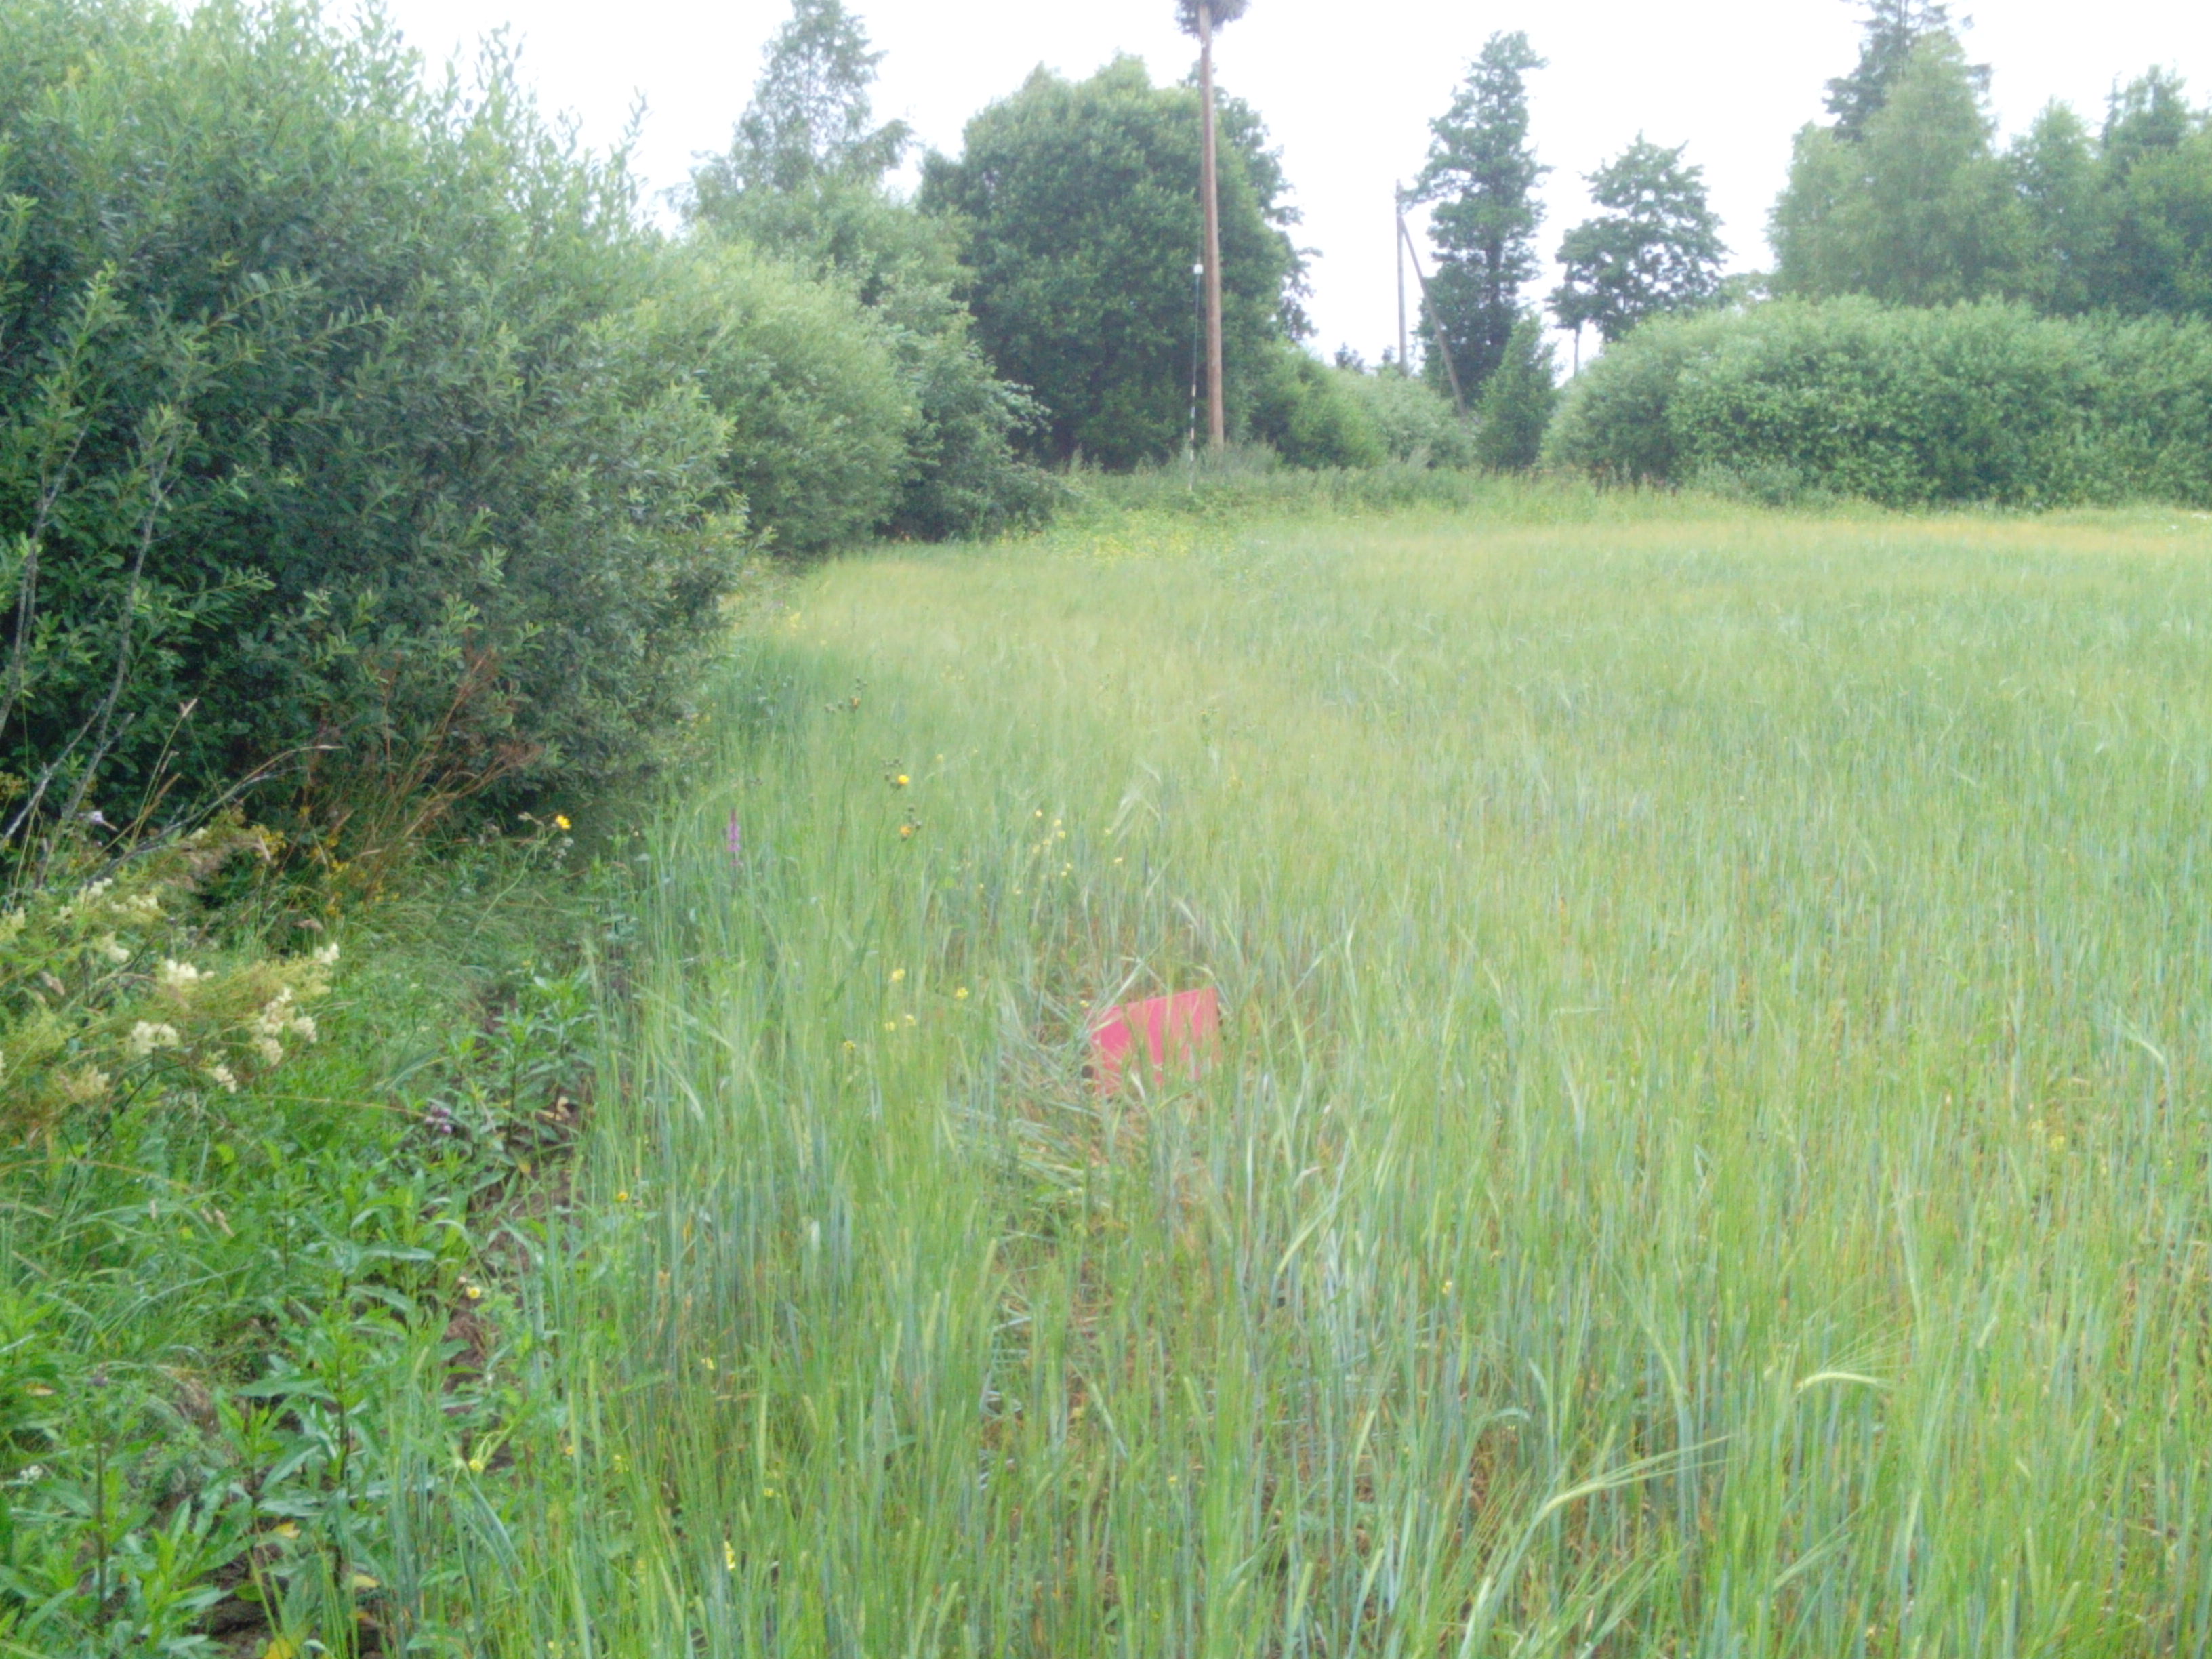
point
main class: Cropland
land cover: Barley
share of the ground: > 75 %
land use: Agriculture (excluding fallow land and kitchen gardens)
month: July
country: LV
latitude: 57.0097
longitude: 22.1528
